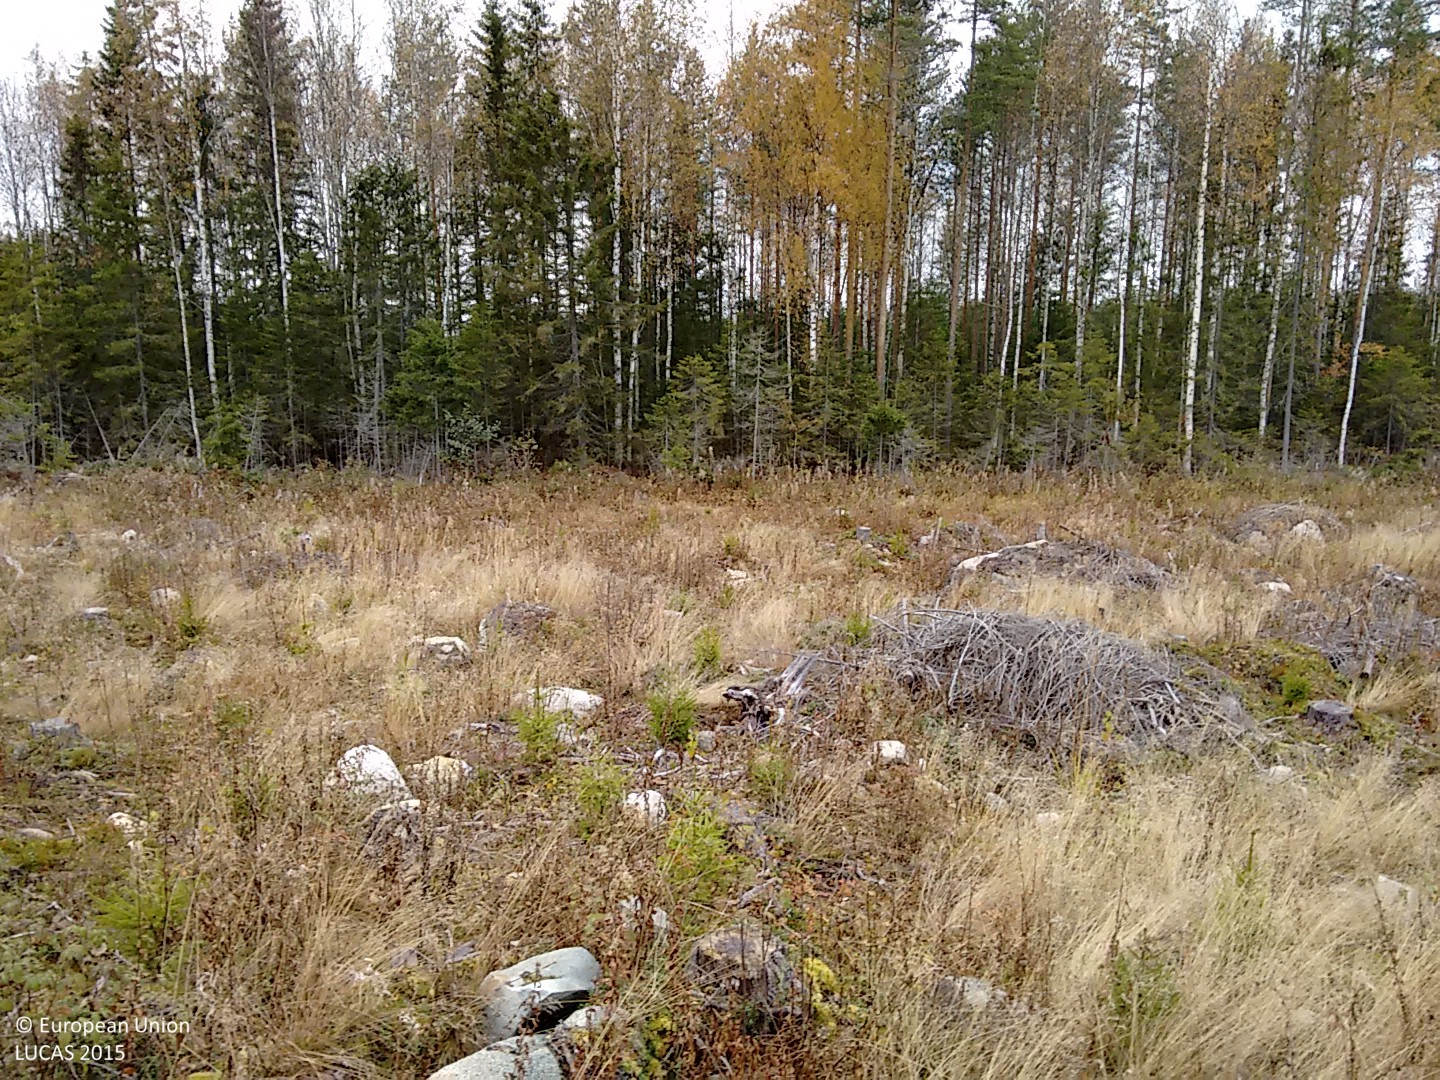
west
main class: Woodland
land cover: Other mixed woodland
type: boreal forest
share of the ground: 50 - 75 %
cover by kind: coniferous forest trees 35 %, broadleaved forest trees 35 %, herbaceous plants 15 %, shrubs 10 %, unconsolidated bare surface 5 %
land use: Forestry
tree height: < 5 m
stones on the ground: > 50 %
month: October
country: FI
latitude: 62.7051
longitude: 26.3754
